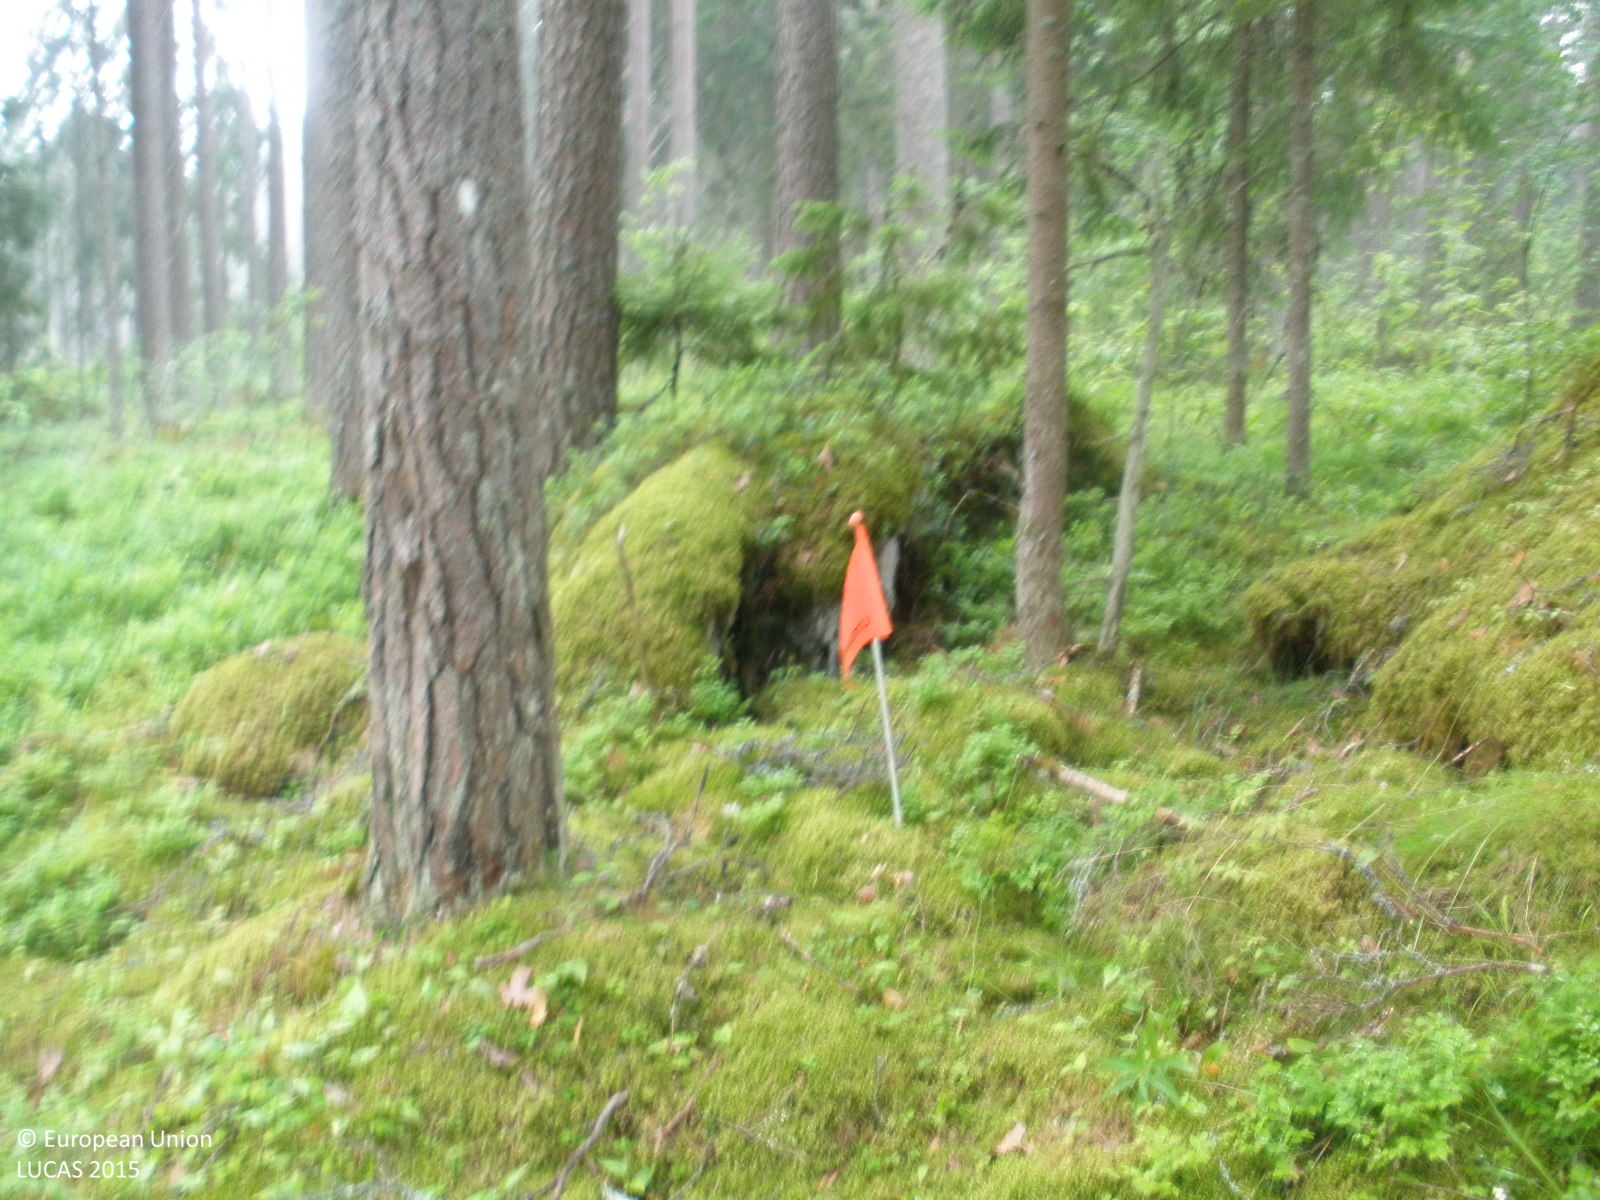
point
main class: Woodland
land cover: Pine dominated coniferous woodland
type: boreal forest
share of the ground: > 75 %
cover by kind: coniferous forest trees 75 %, shrubs 10 %, lichens and mosses 10 %, herbaceous plants 5 %
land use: Forestry
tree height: > 5 m
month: July
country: FI
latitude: 61.3659
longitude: 24.5609
